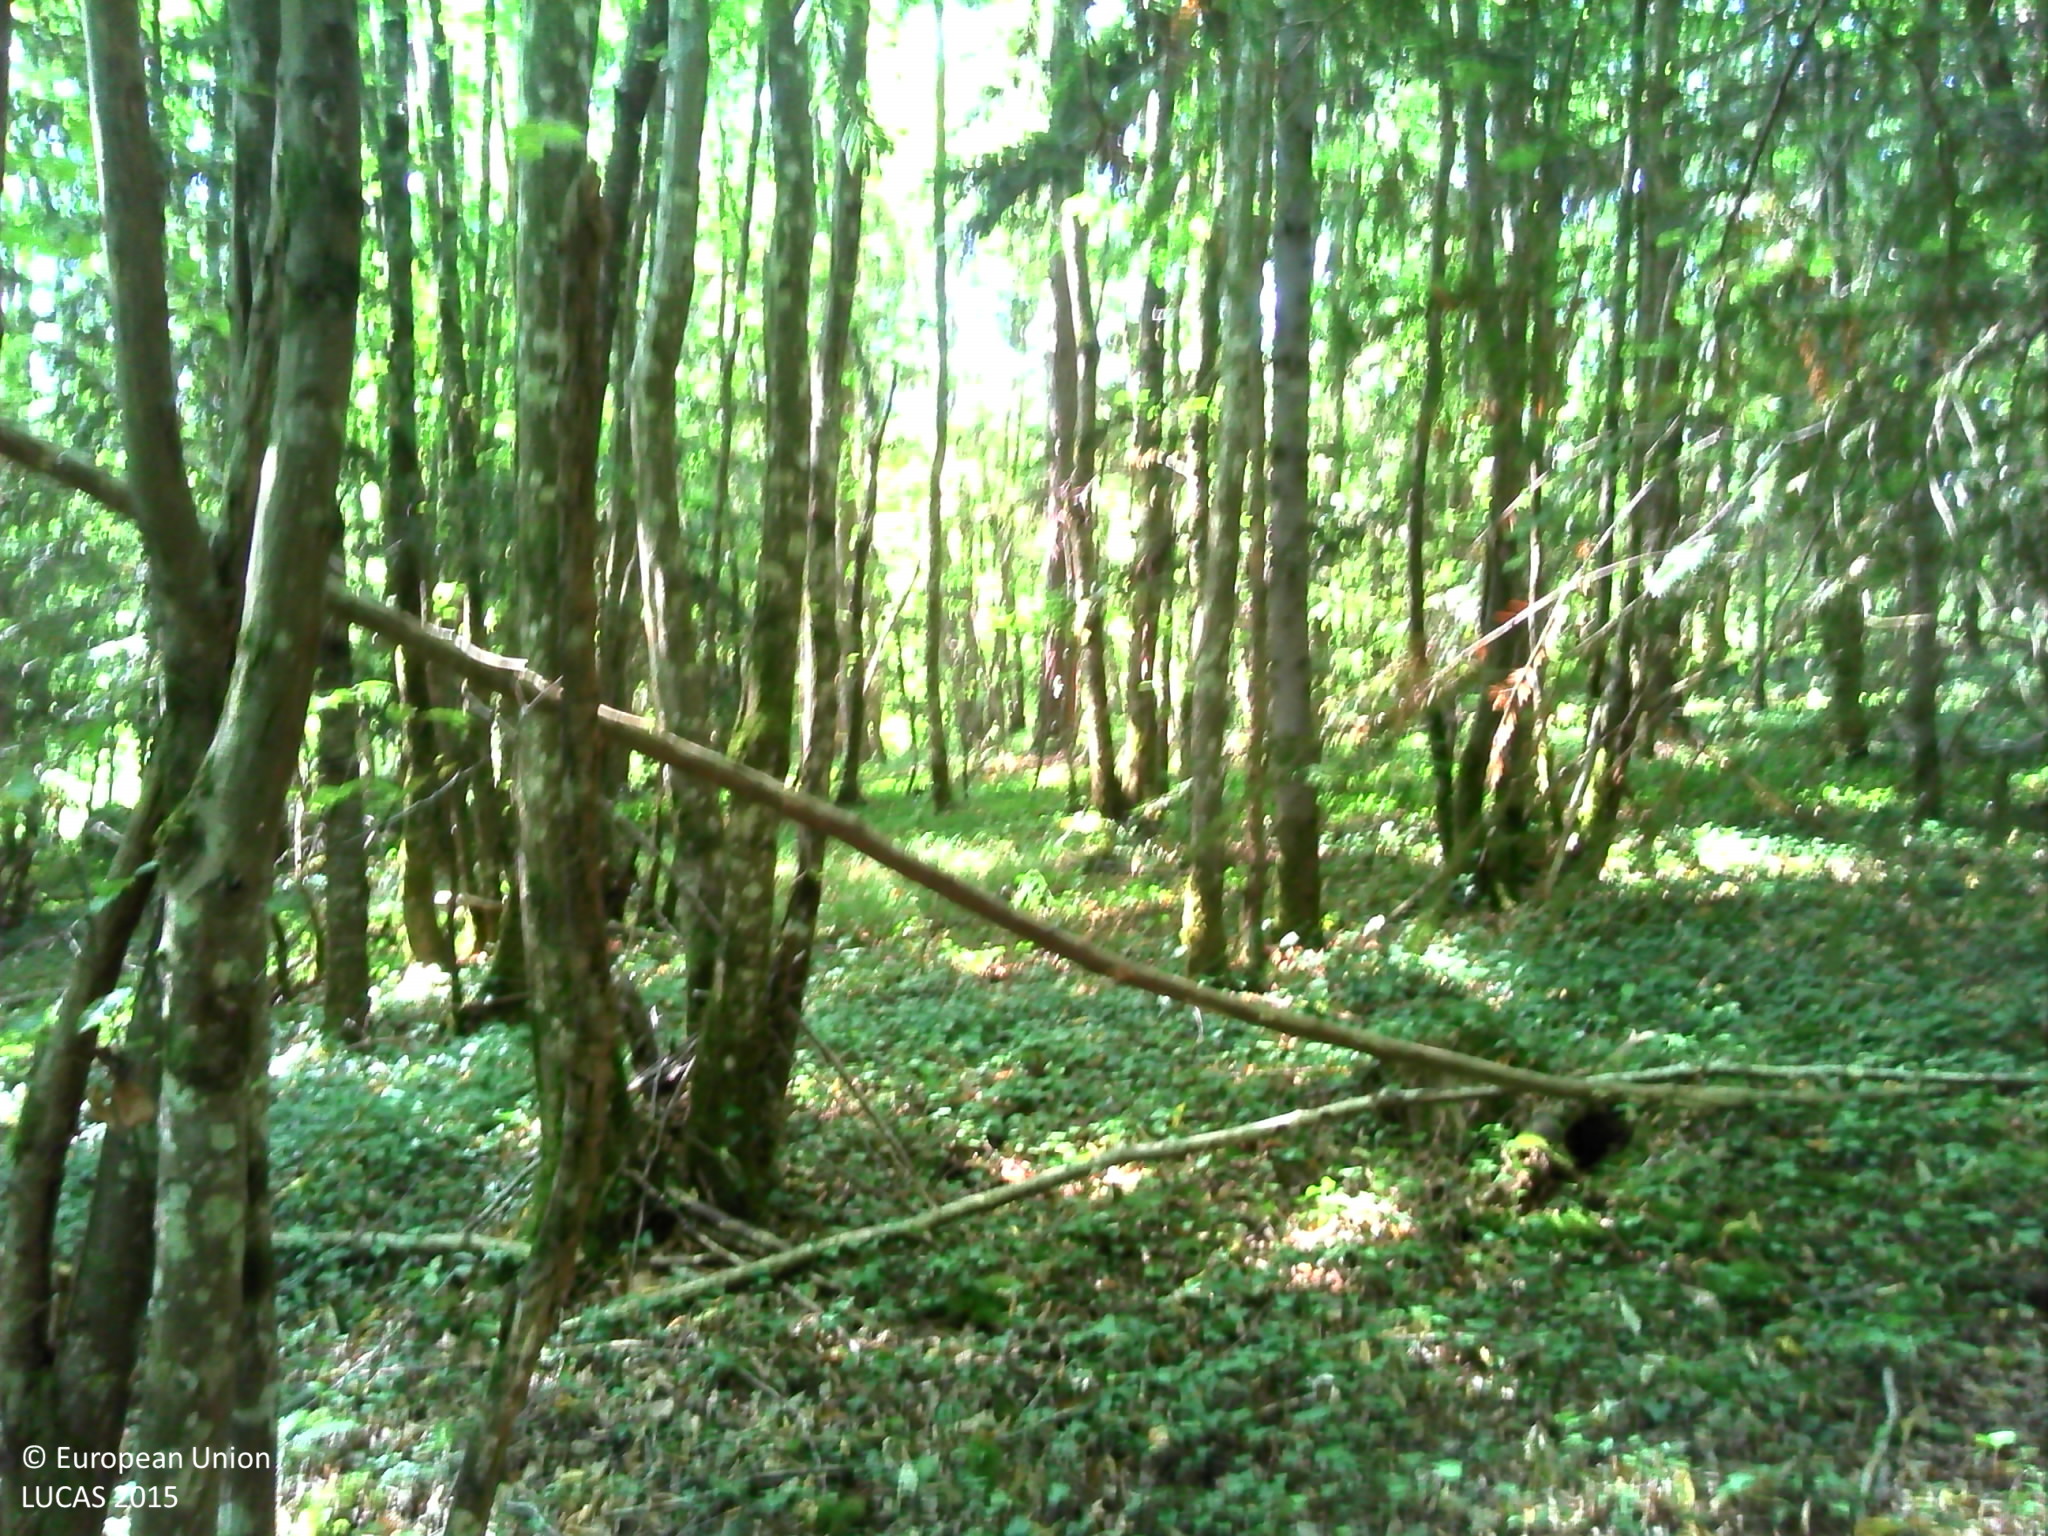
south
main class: Woodland
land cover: Pine dominated coniferous woodland
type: hemiboreal forest and nemoral coniferous forest and mixed broadleaved-coniferous forest
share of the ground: > 75 %
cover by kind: coniferous forest trees 80 %, herbaceous plants 10 %, shrubs 5 %, lichens and mosses 5 %
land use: Forestry
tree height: > 5 m
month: August
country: FR
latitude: 44.7716
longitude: 0.7557
